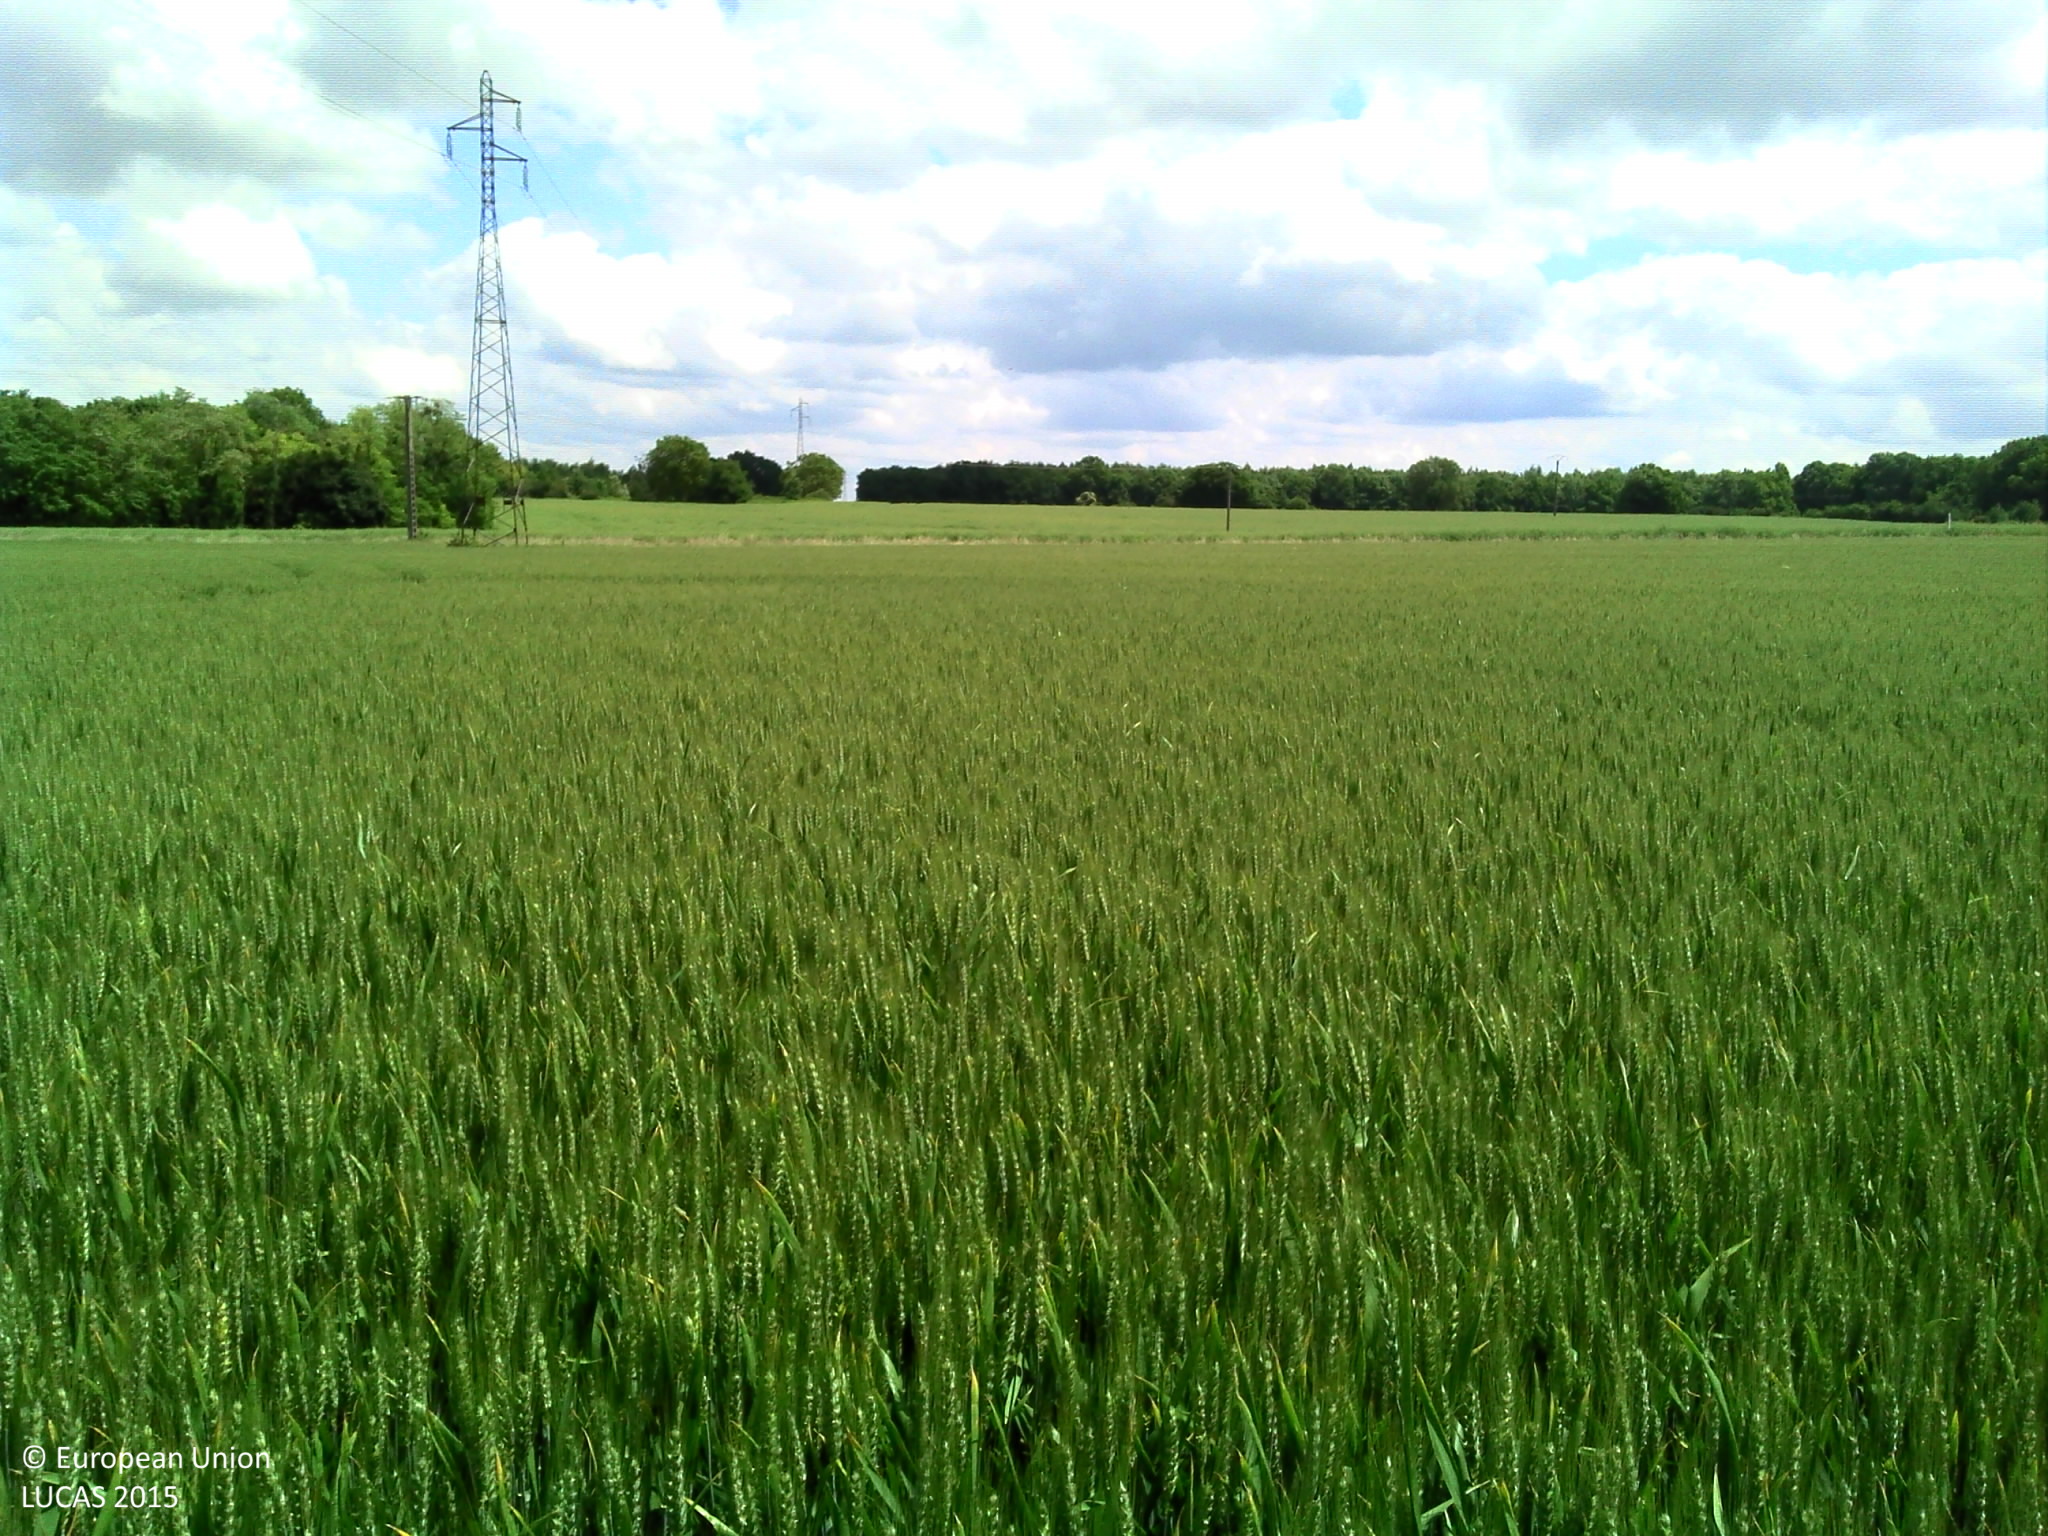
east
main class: Cropland
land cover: Common wheat
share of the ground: > 75 %
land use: Agriculture (excluding fallow land and kitchen gardens)
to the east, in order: Common wheat; Ditches and canals; Grass margins; Paved roads, cycling and walking lanes; Grass margins; Ditches and canals; Rape and turnip rape; Electric lines; Rape and turnip rape
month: May
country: FR
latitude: 47.2017
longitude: 2.9324
